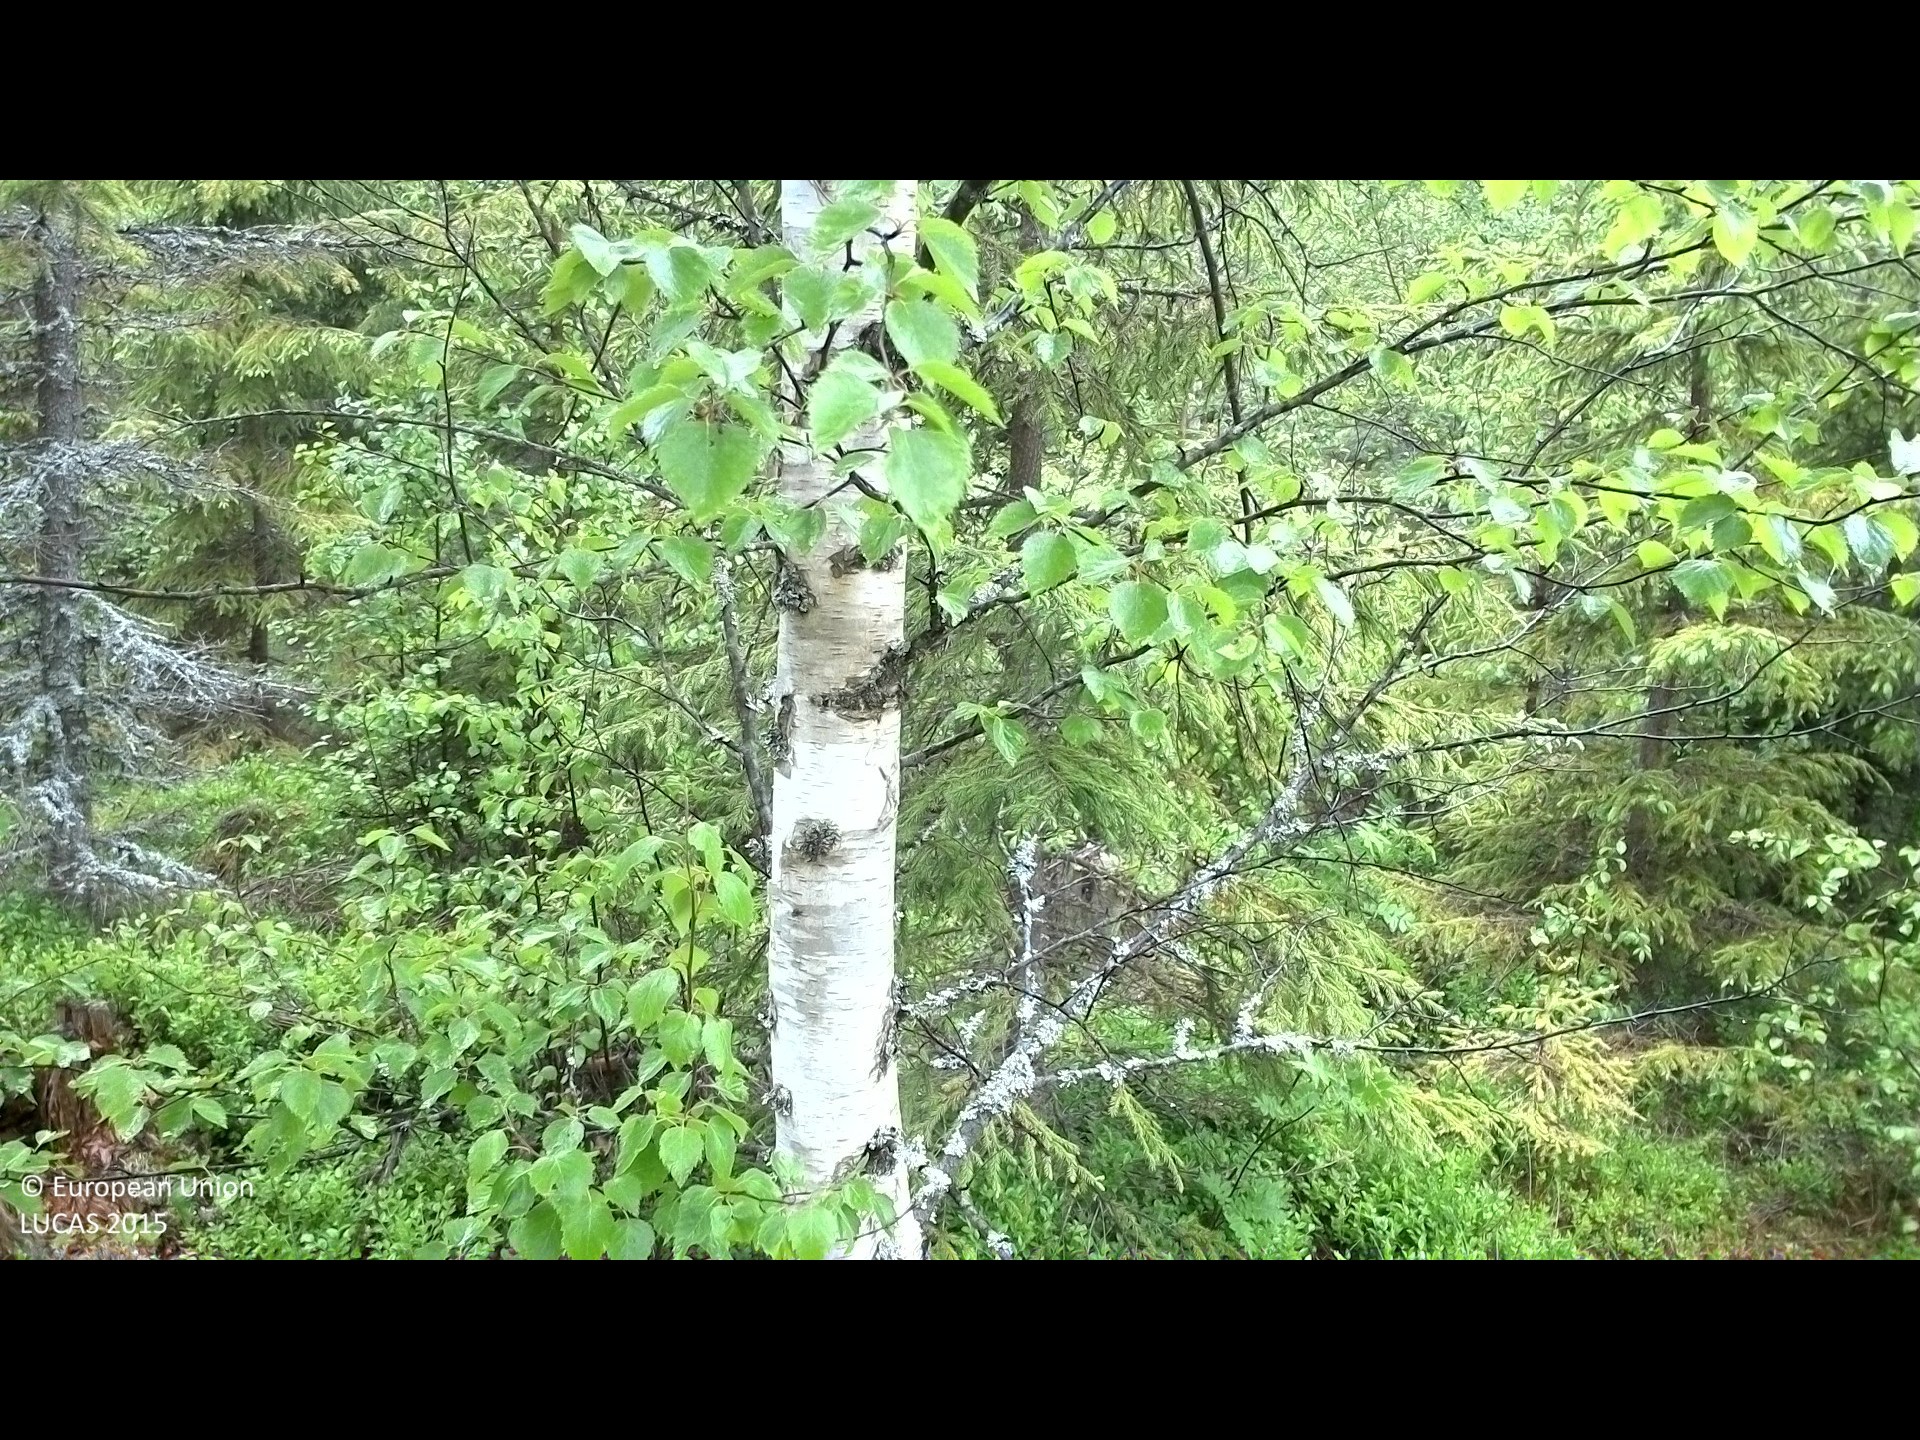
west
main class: Woodland
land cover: Spruce dominated mixed woodland
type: boreal forest
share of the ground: 25 - 50 %
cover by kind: shrubs 50 %, coniferous forest trees 25 %, broadleaved forest trees 15 %, lichens and mosses 10 %
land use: Forestry
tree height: > 5 m
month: June
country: SE
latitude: 62.1532
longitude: 17.1395
